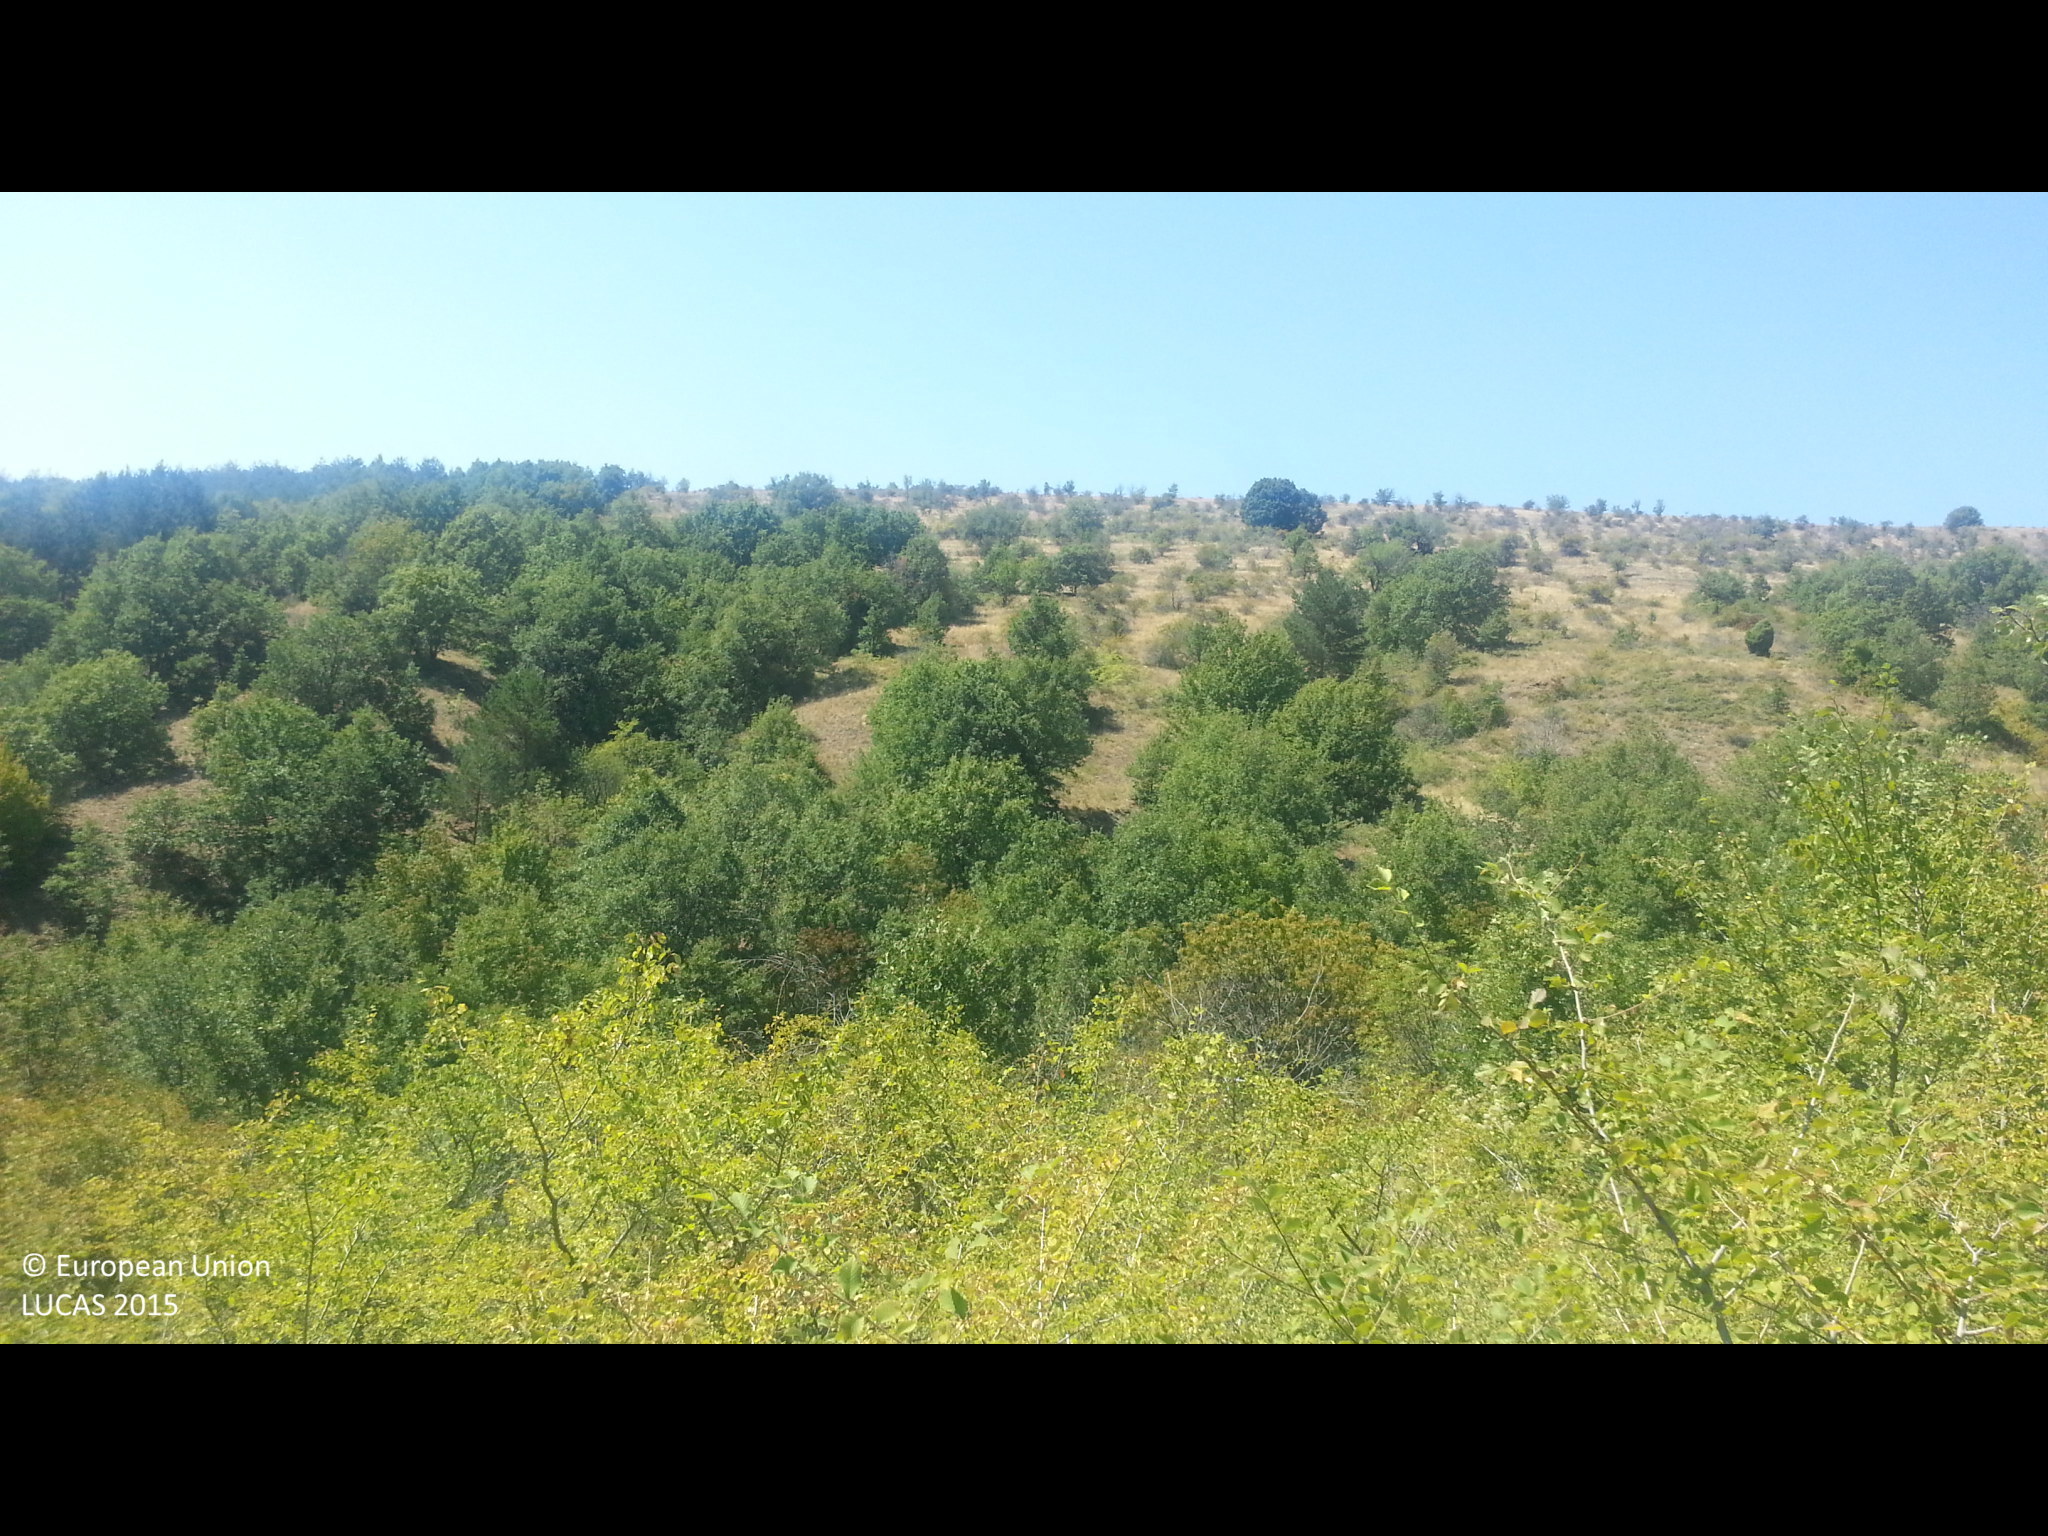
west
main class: Shrubland
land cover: Shrubland without tree cover
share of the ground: 50 - 75 %
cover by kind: shrubs 70 %, herbaceous plants 30 %
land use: Semi-natural and natural areas not in use
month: September
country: BG
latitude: 42.1935
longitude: 23.0186
